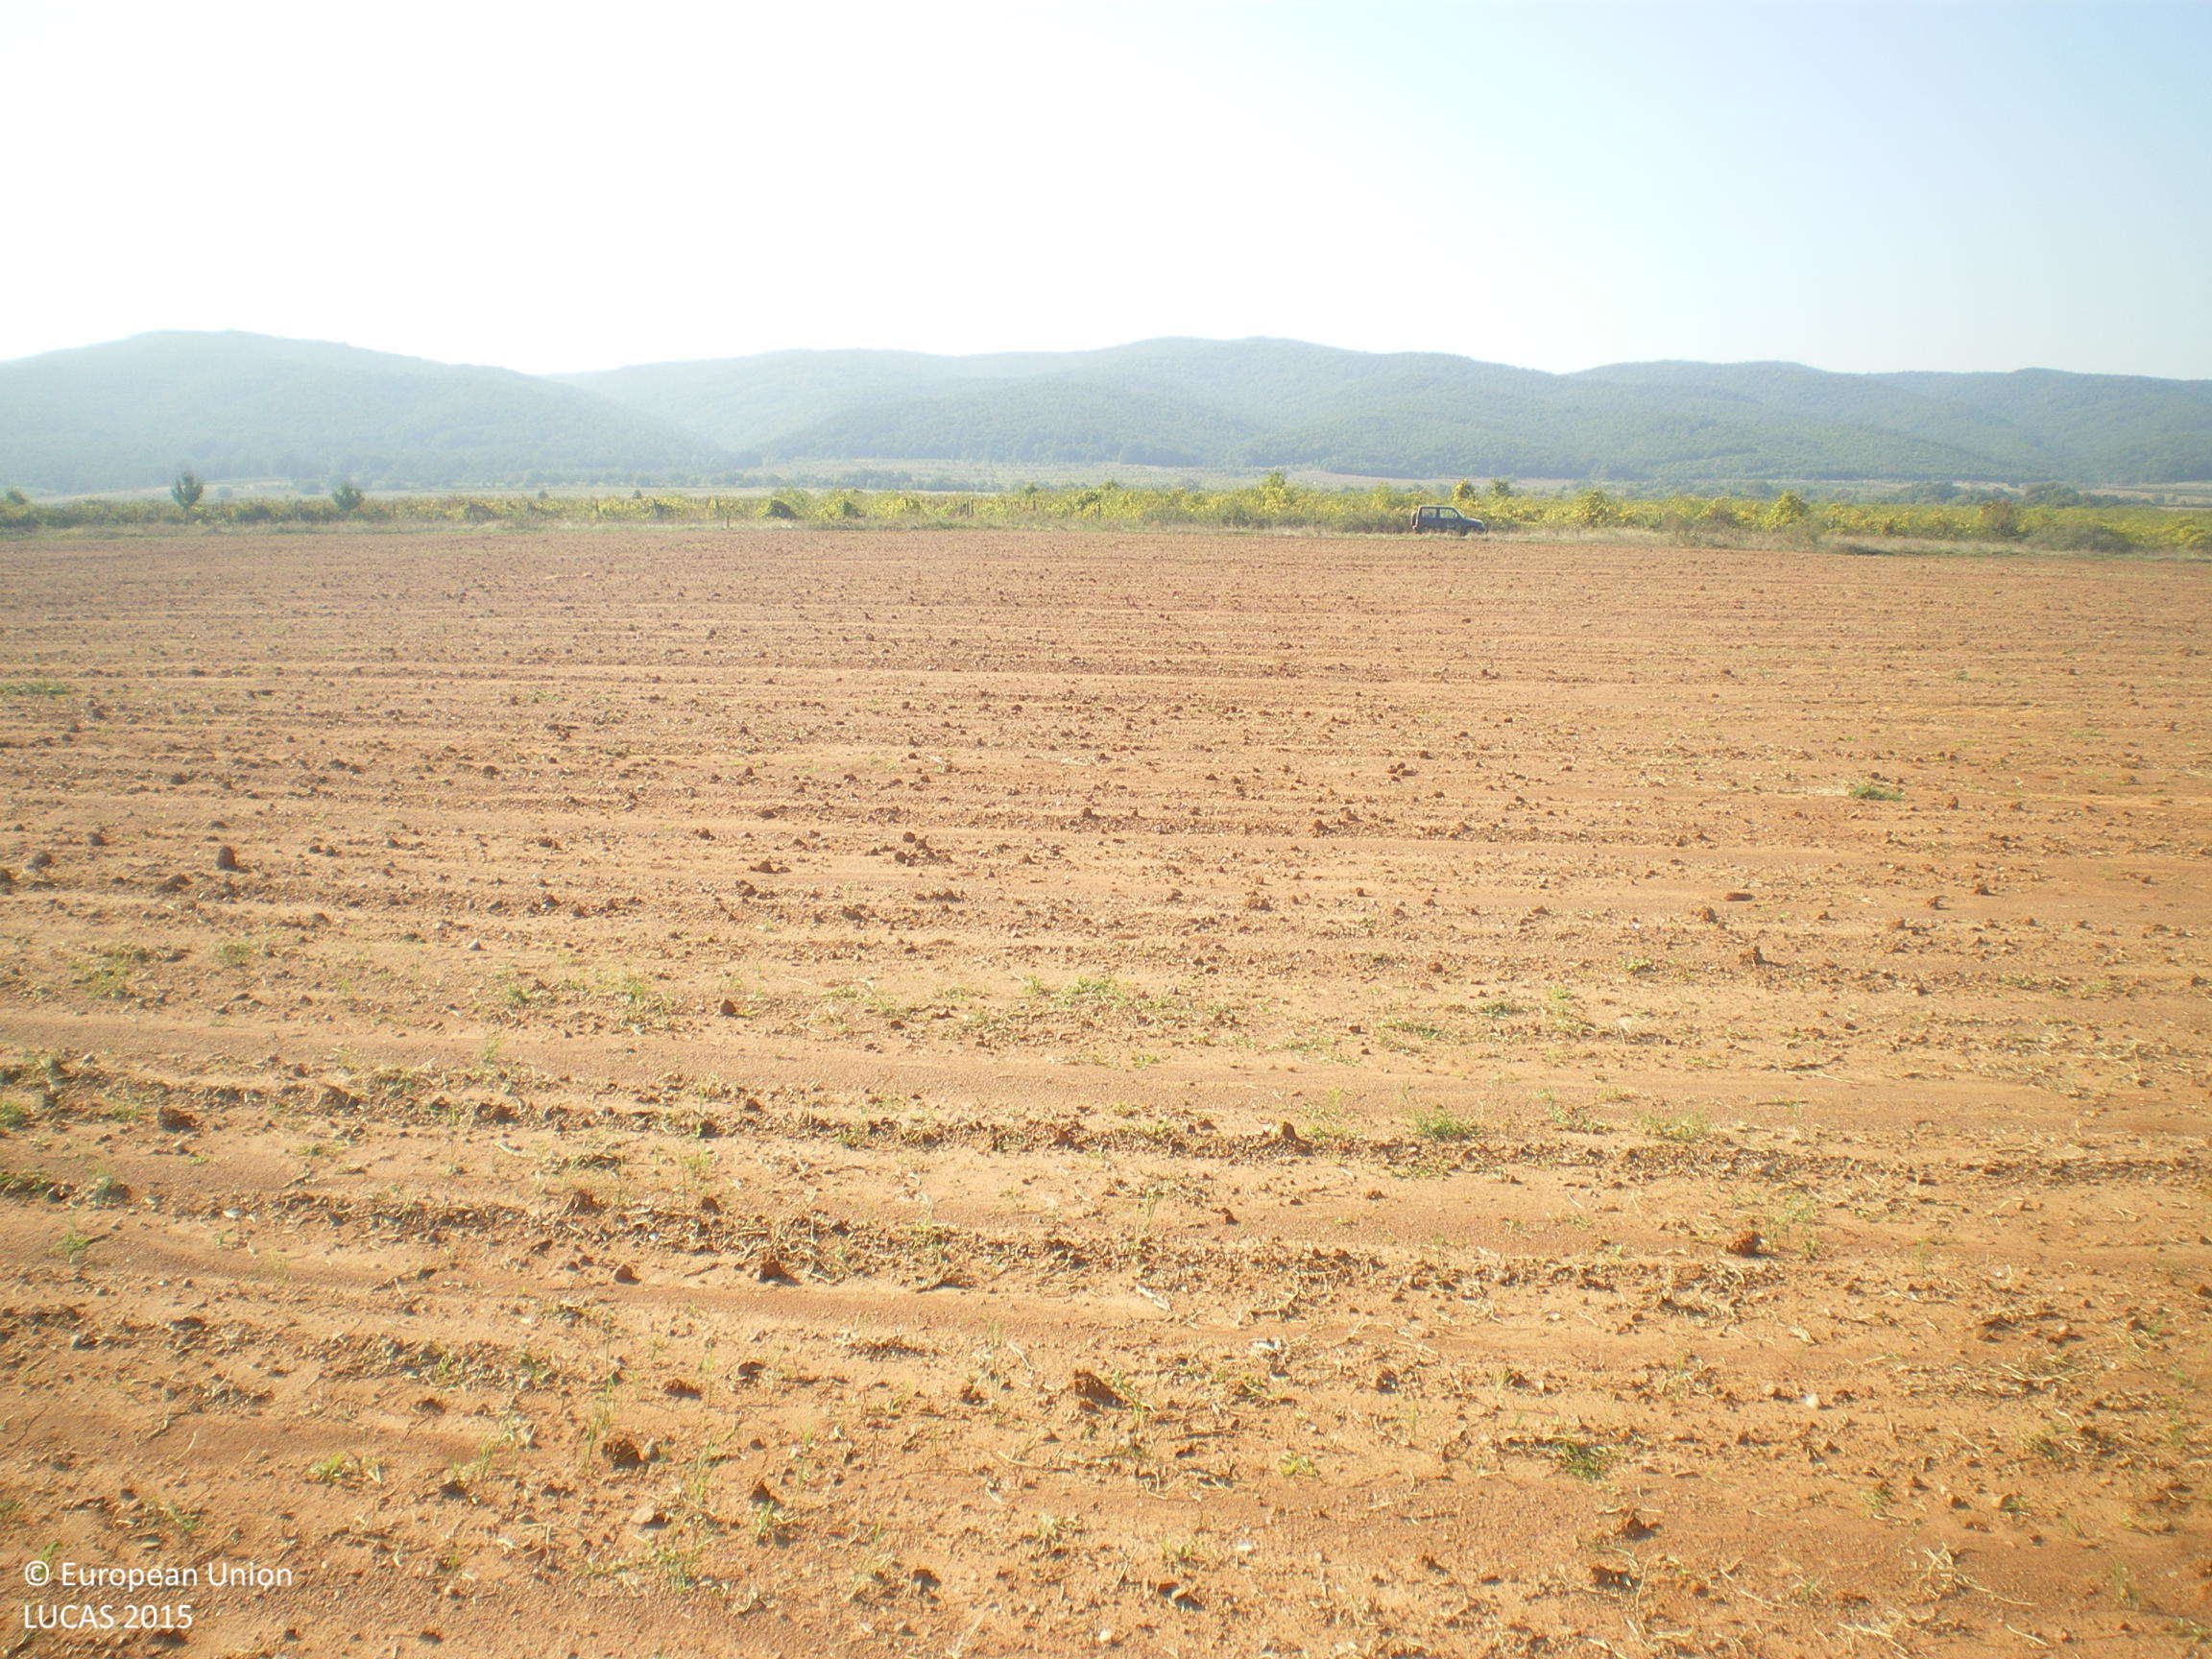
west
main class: Cropland
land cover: Common wheat
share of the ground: < 10 %
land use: Agriculture (excluding fallow land and kitchen gardens)
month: September
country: BG
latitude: 41.7762
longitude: 25.8895
